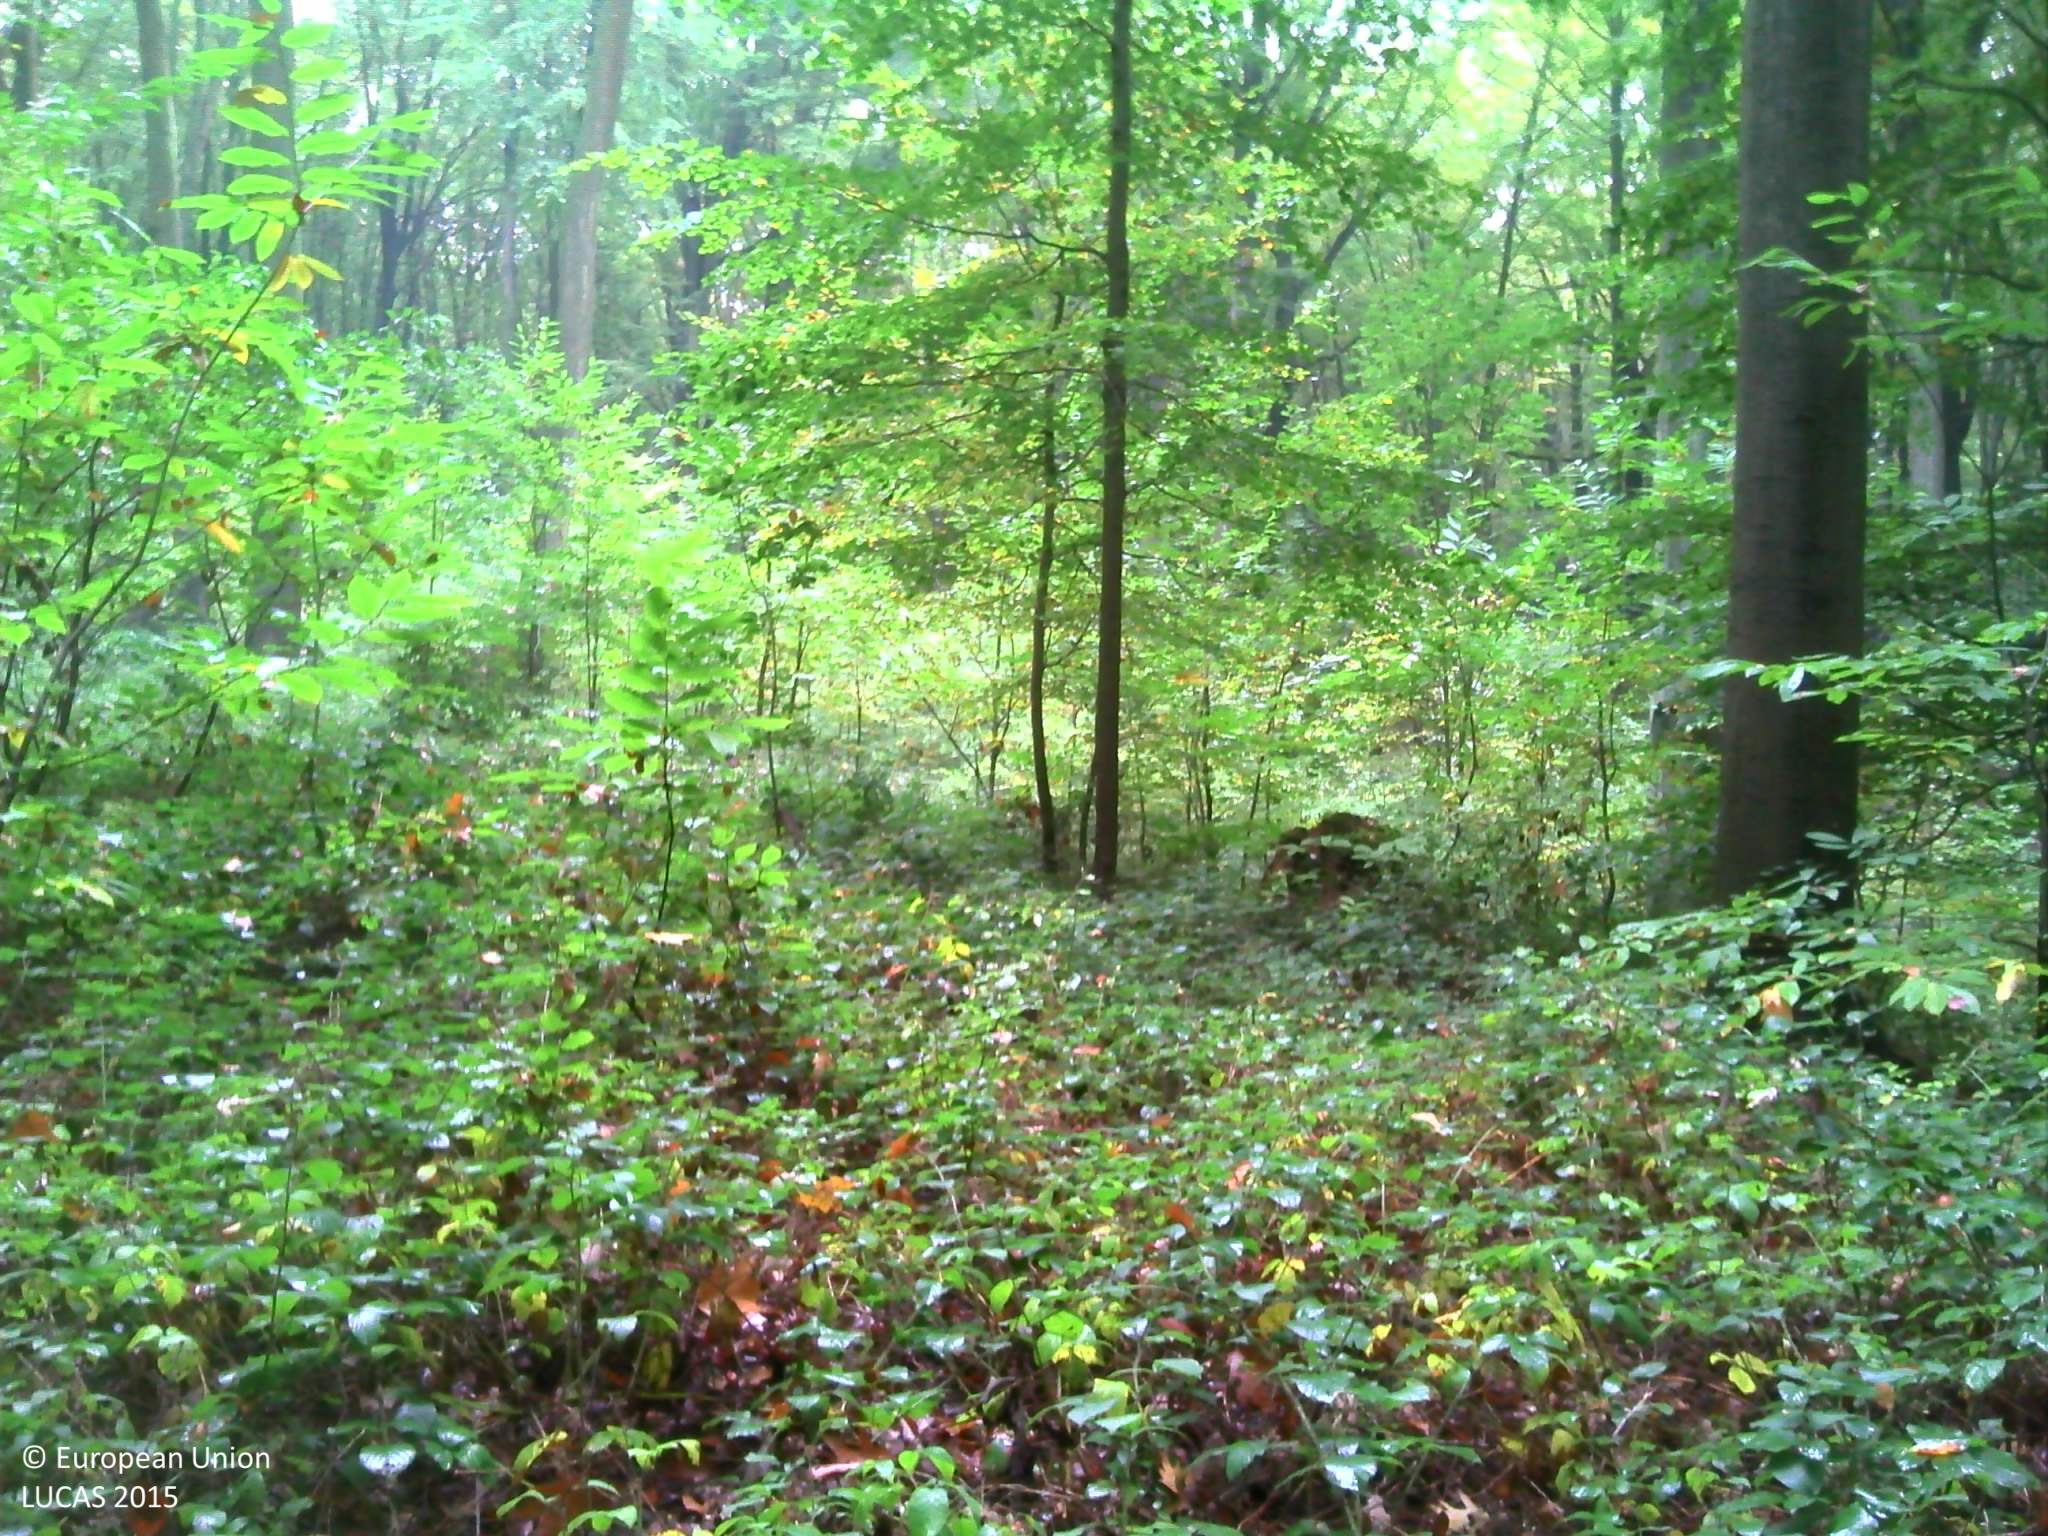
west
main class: Woodland
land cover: Broadleaved woodland
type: beech forest
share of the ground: > 75 %
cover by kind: broadleaved forest trees 80 %, shrubs 10 %, herbaceous plants 10 %
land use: Forestry
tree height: > 5 m
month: October
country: BE
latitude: 50.8651
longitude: 4.5541
